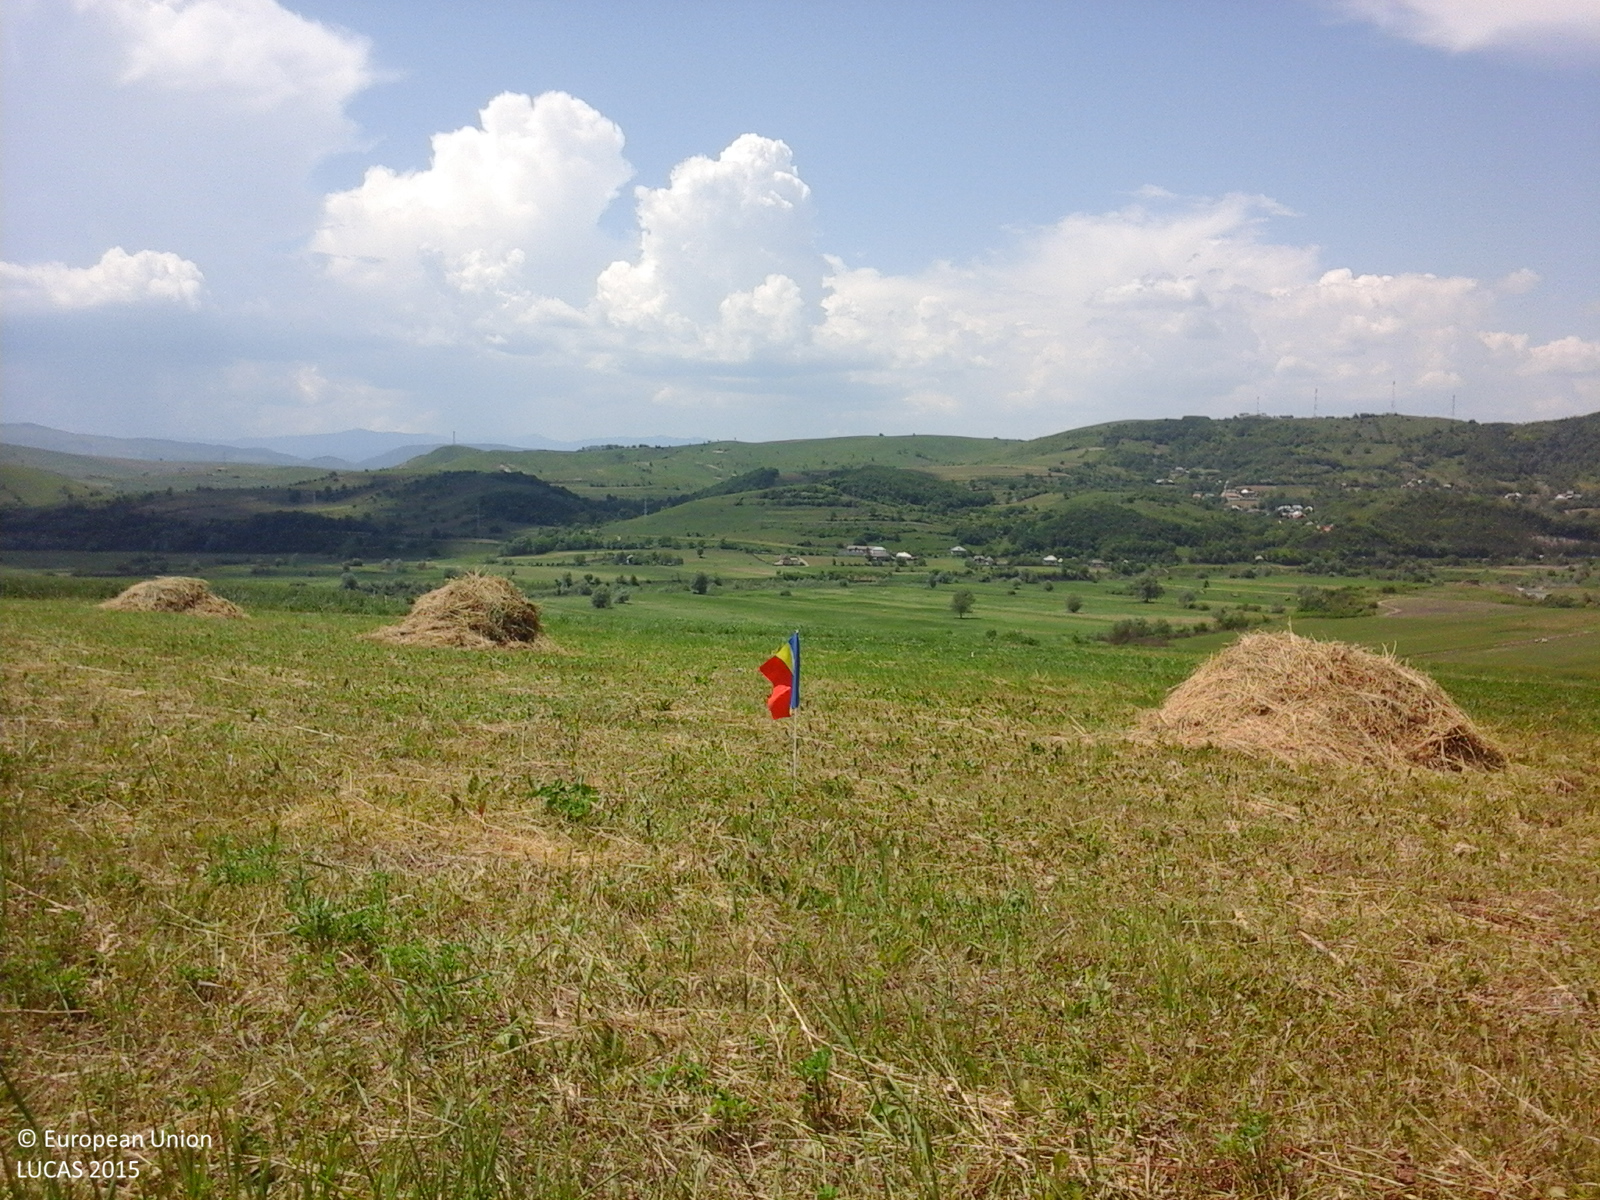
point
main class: Grassland
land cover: Grassland without tree/shrub cover
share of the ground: > 75 %
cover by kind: herbaceous plants 90 %, unconsolidated bare surface 10 %
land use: Agriculture (excluding fallow land and kitchen gardens)
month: June
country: RO
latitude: 46.3015
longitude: 26.7713
